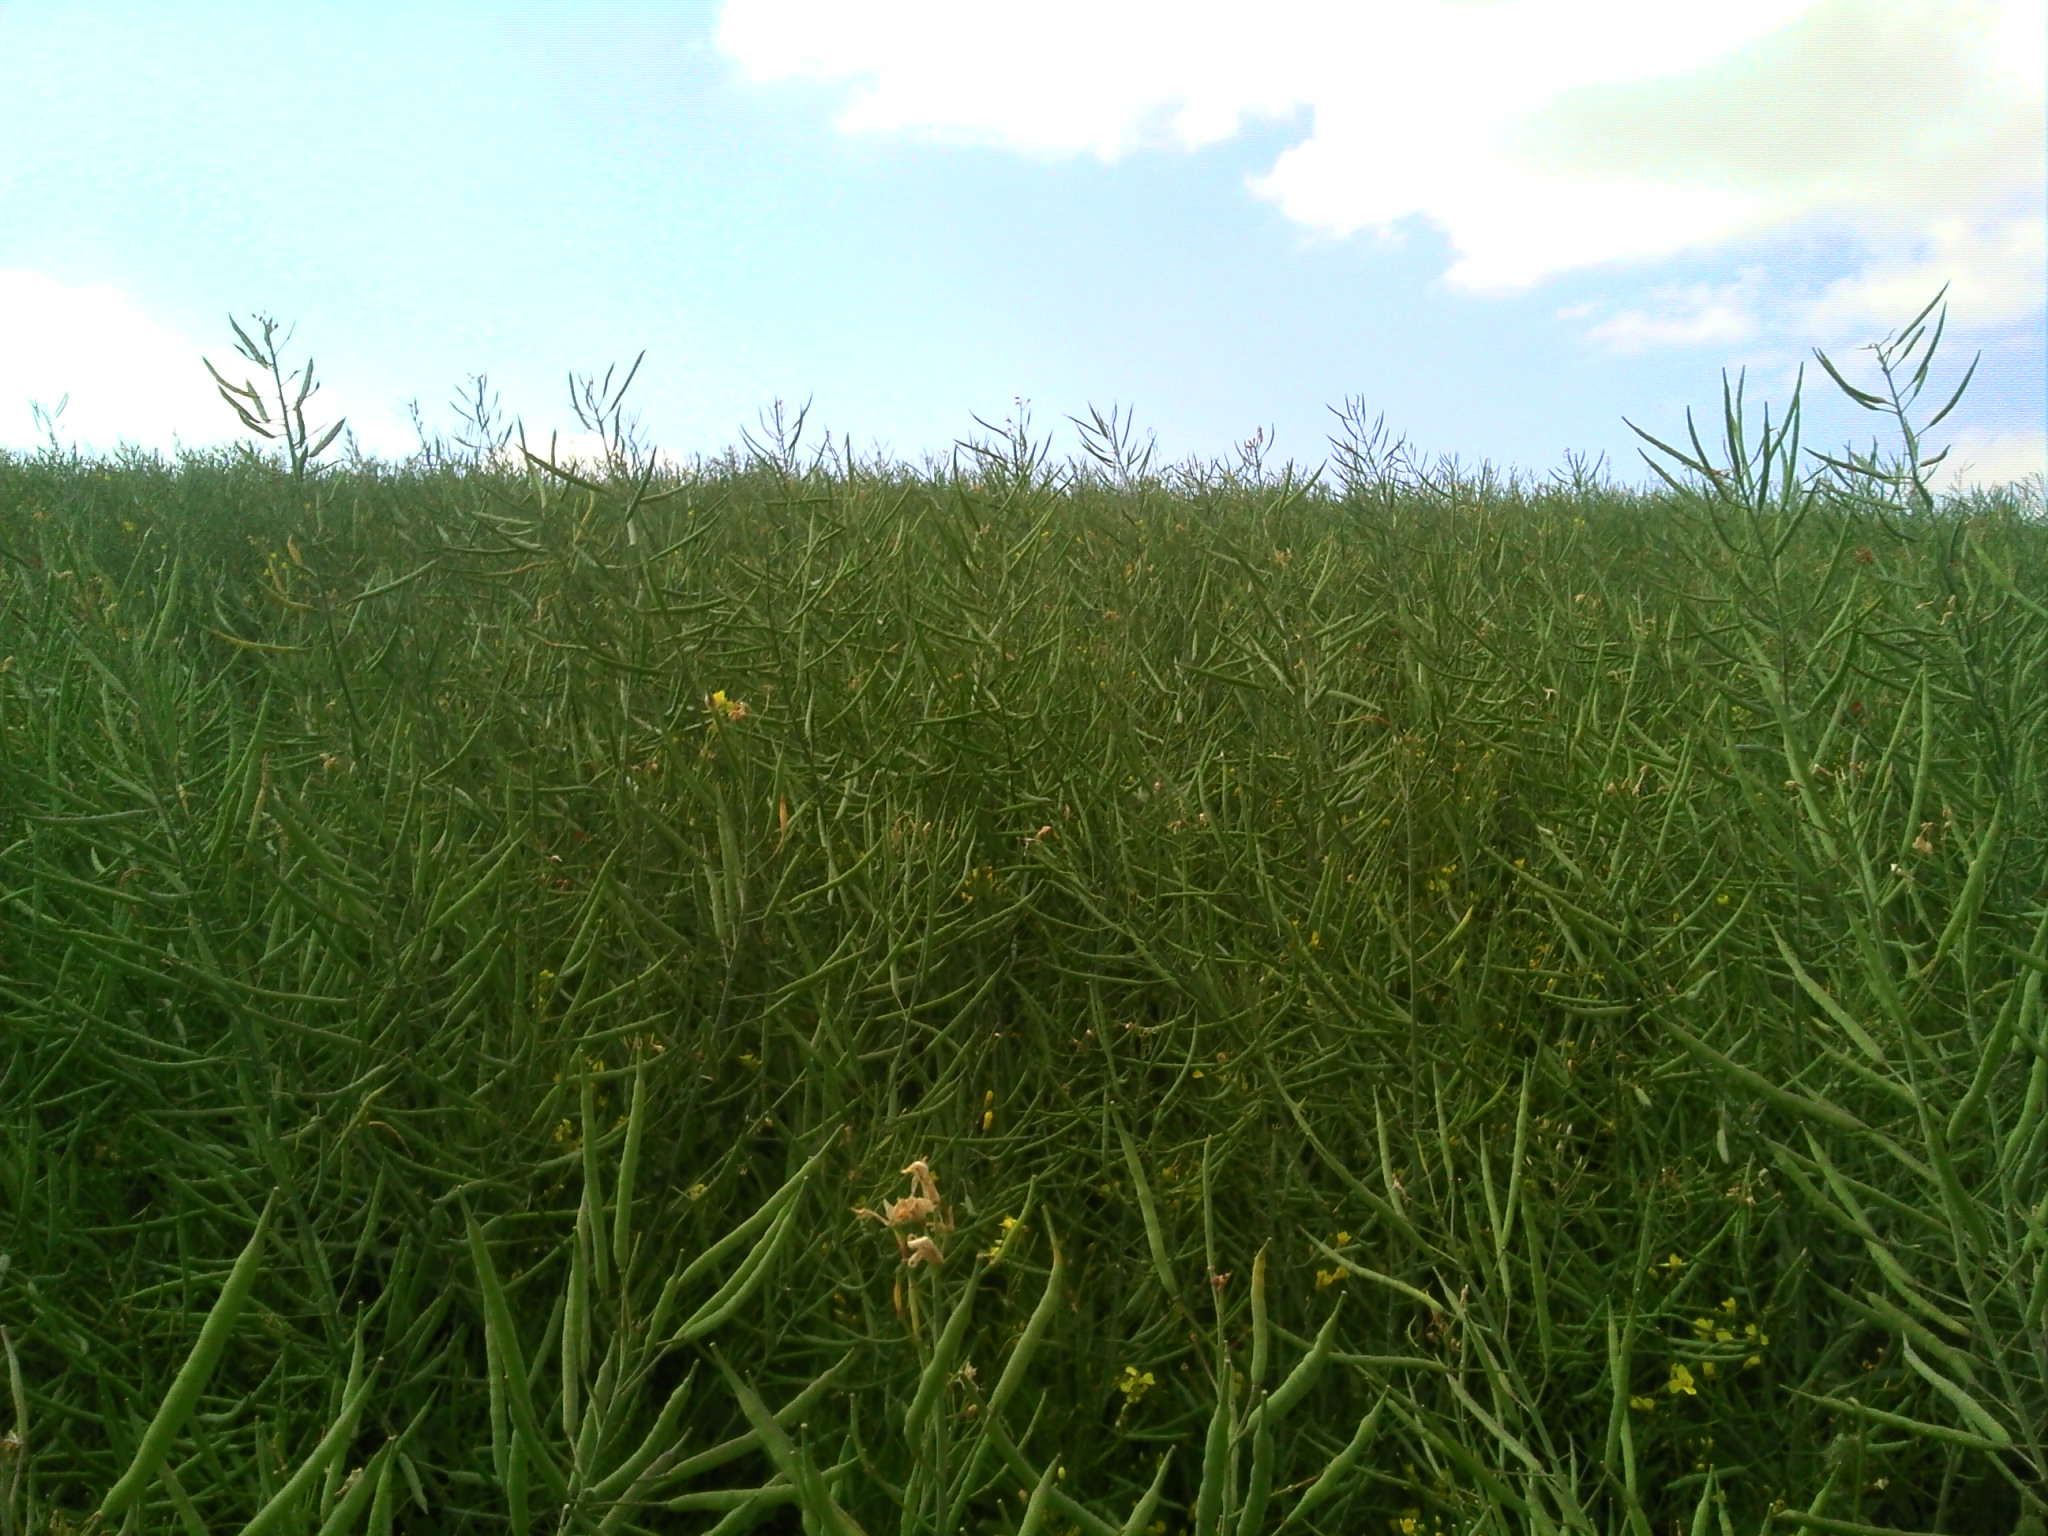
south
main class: Cropland
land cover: Rape and turnip rape
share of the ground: > 75 %
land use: Agriculture (excluding fallow land and kitchen gardens)
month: June
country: BE
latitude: 50.3583
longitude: 5.3172
